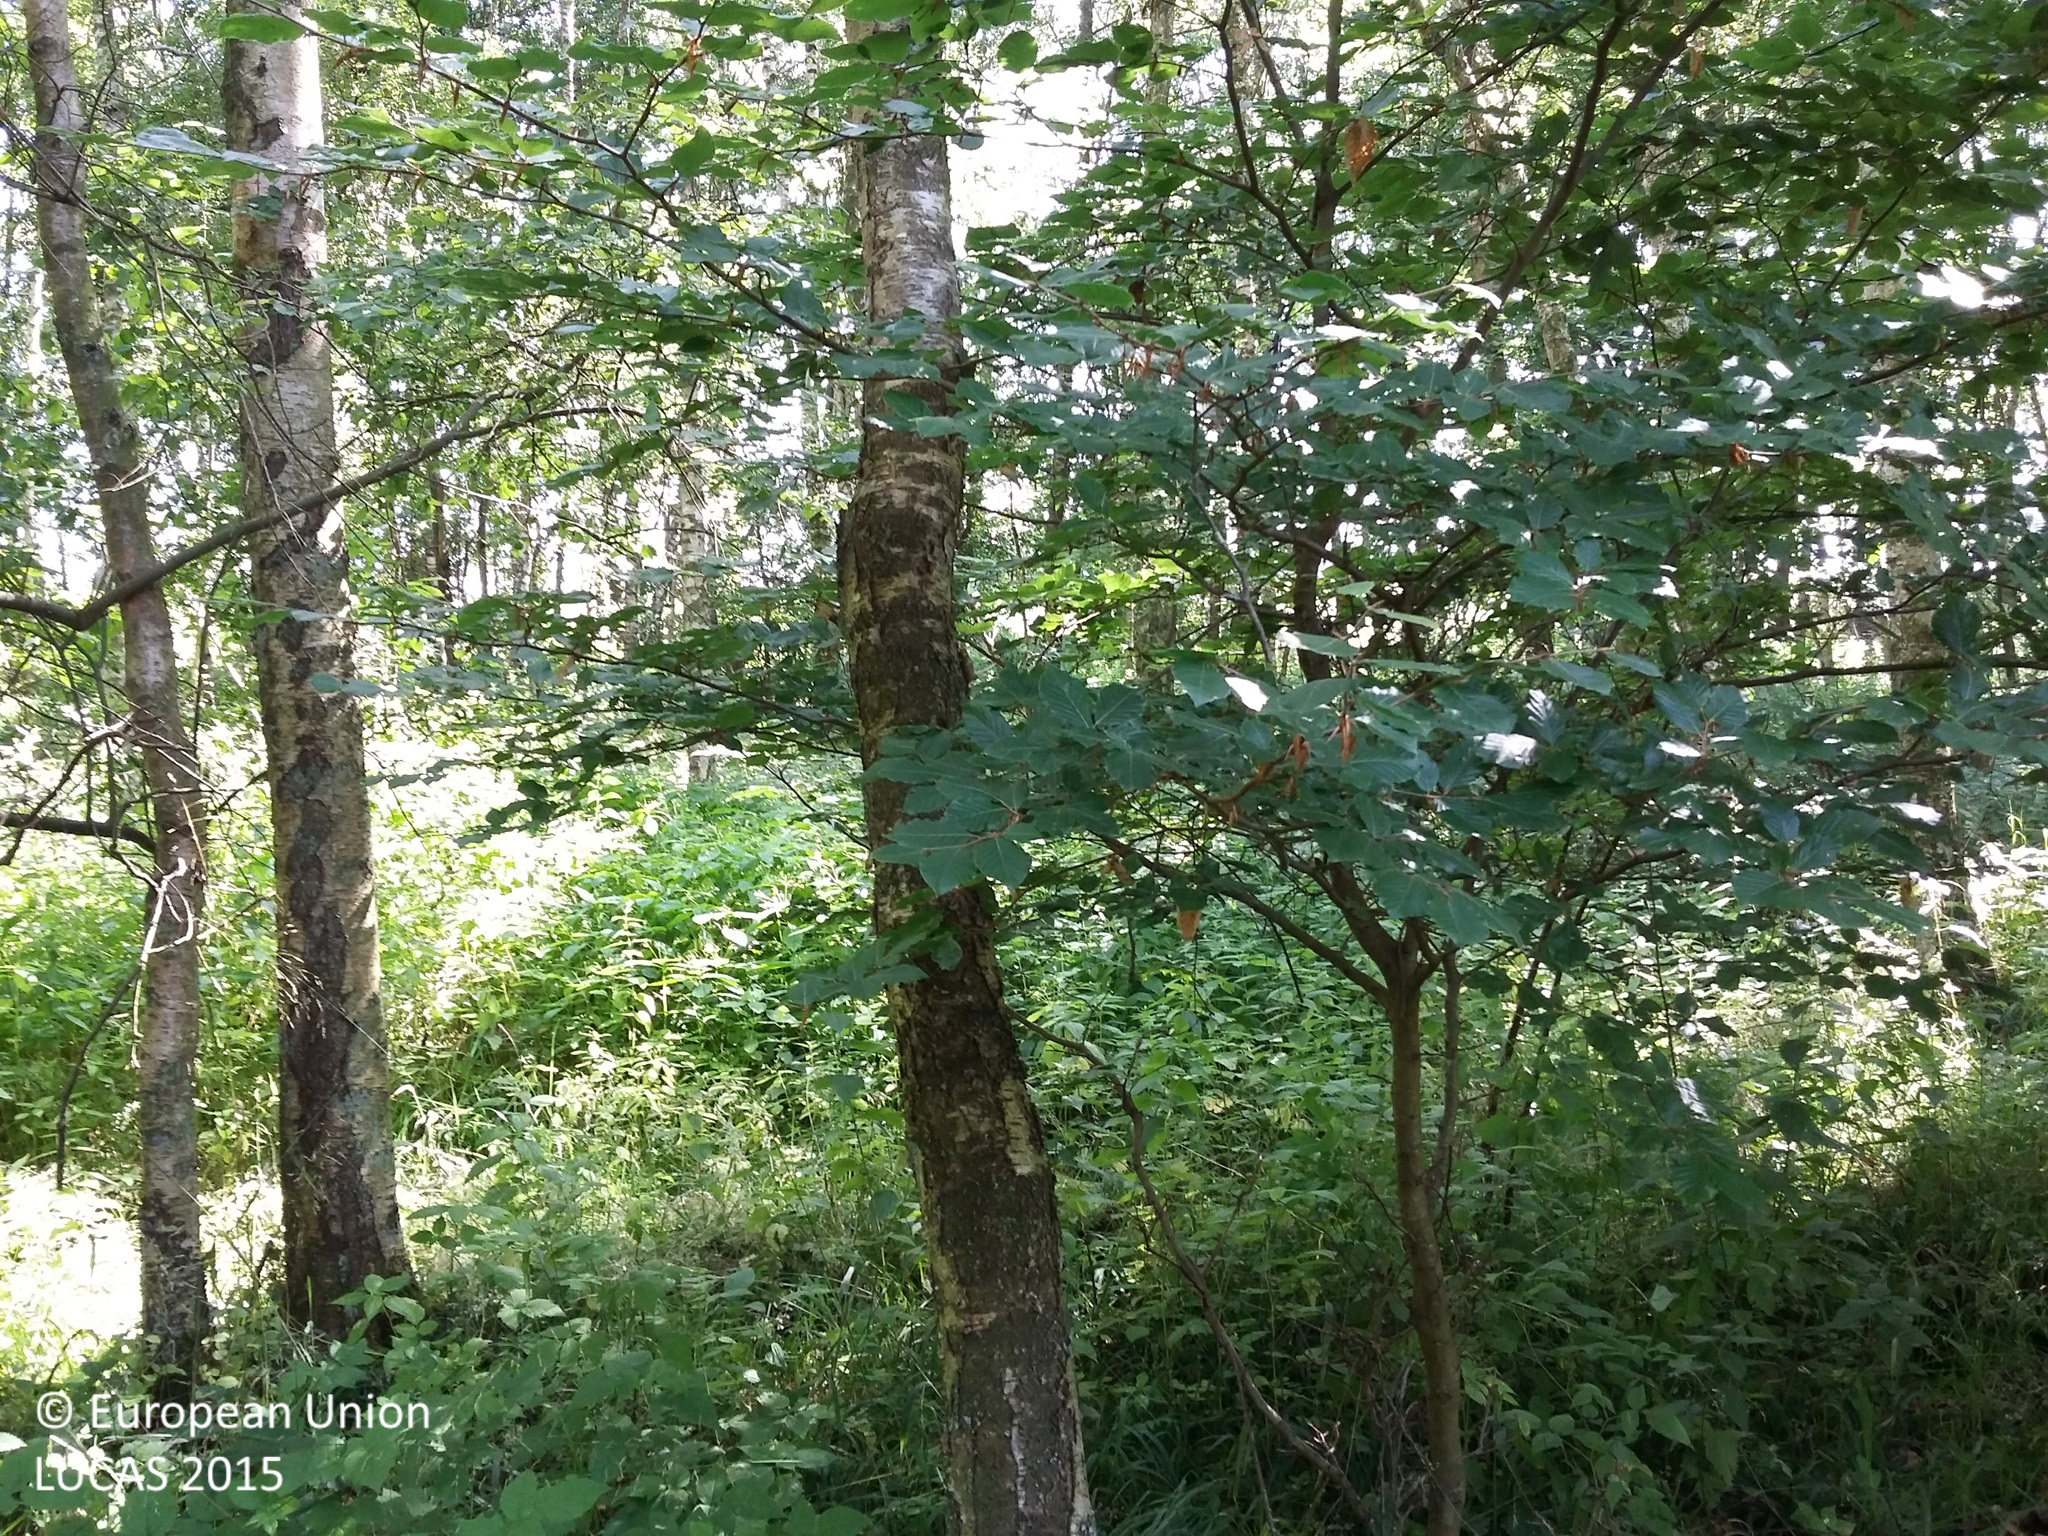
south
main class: Woodland
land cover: Broadleaved woodland
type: acidophilous oak and oak-birch forest
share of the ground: > 75 %
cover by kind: broadleaved forest trees 70 %, herbaceous plants 20 %, shrubs 10 %
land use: Forestry
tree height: > 5 m
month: August
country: DK
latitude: 55.3124
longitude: 11.7790
